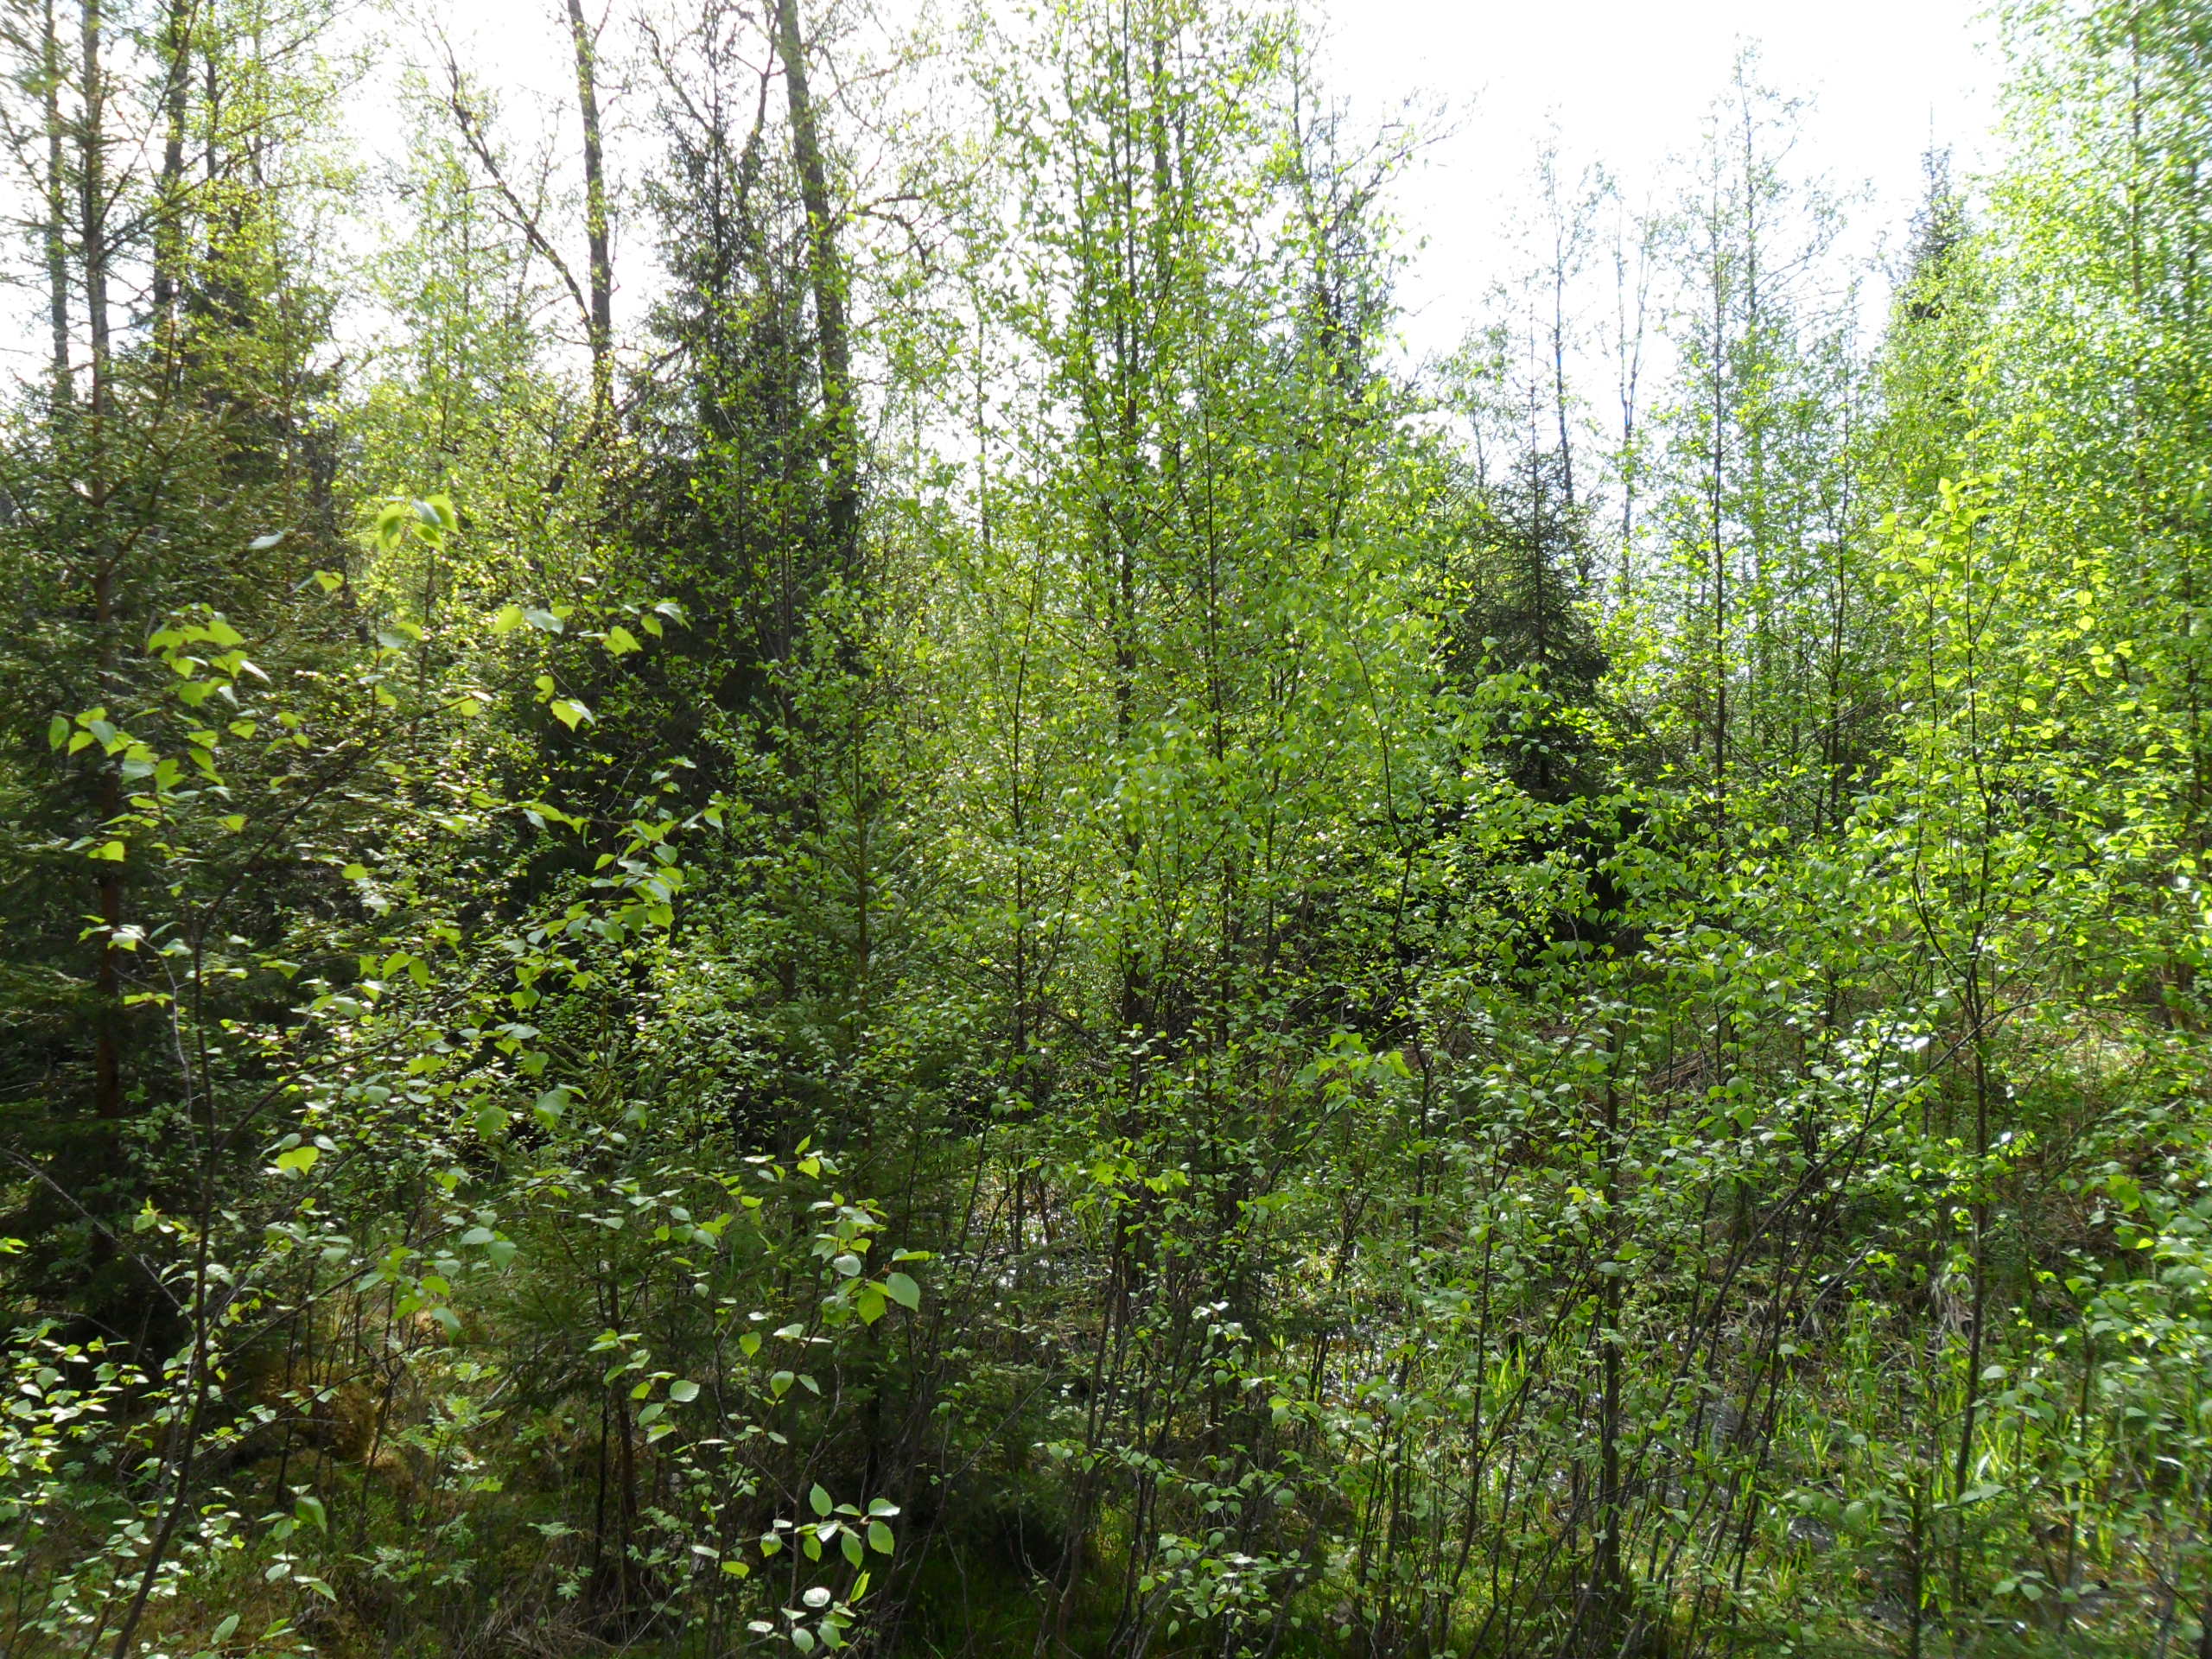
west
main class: Woodland
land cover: Other mixed woodland
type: hemiboreal forest and nemoral coniferous forest and mixed broadleaved-coniferous forest
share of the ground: > 75 %
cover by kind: coniferous forest trees 45 %, broadleaved forest trees 45 %, shrubs 10 %
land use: Forestry
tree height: > 5 m
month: May
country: LV
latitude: 57.1856
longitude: 22.4121
